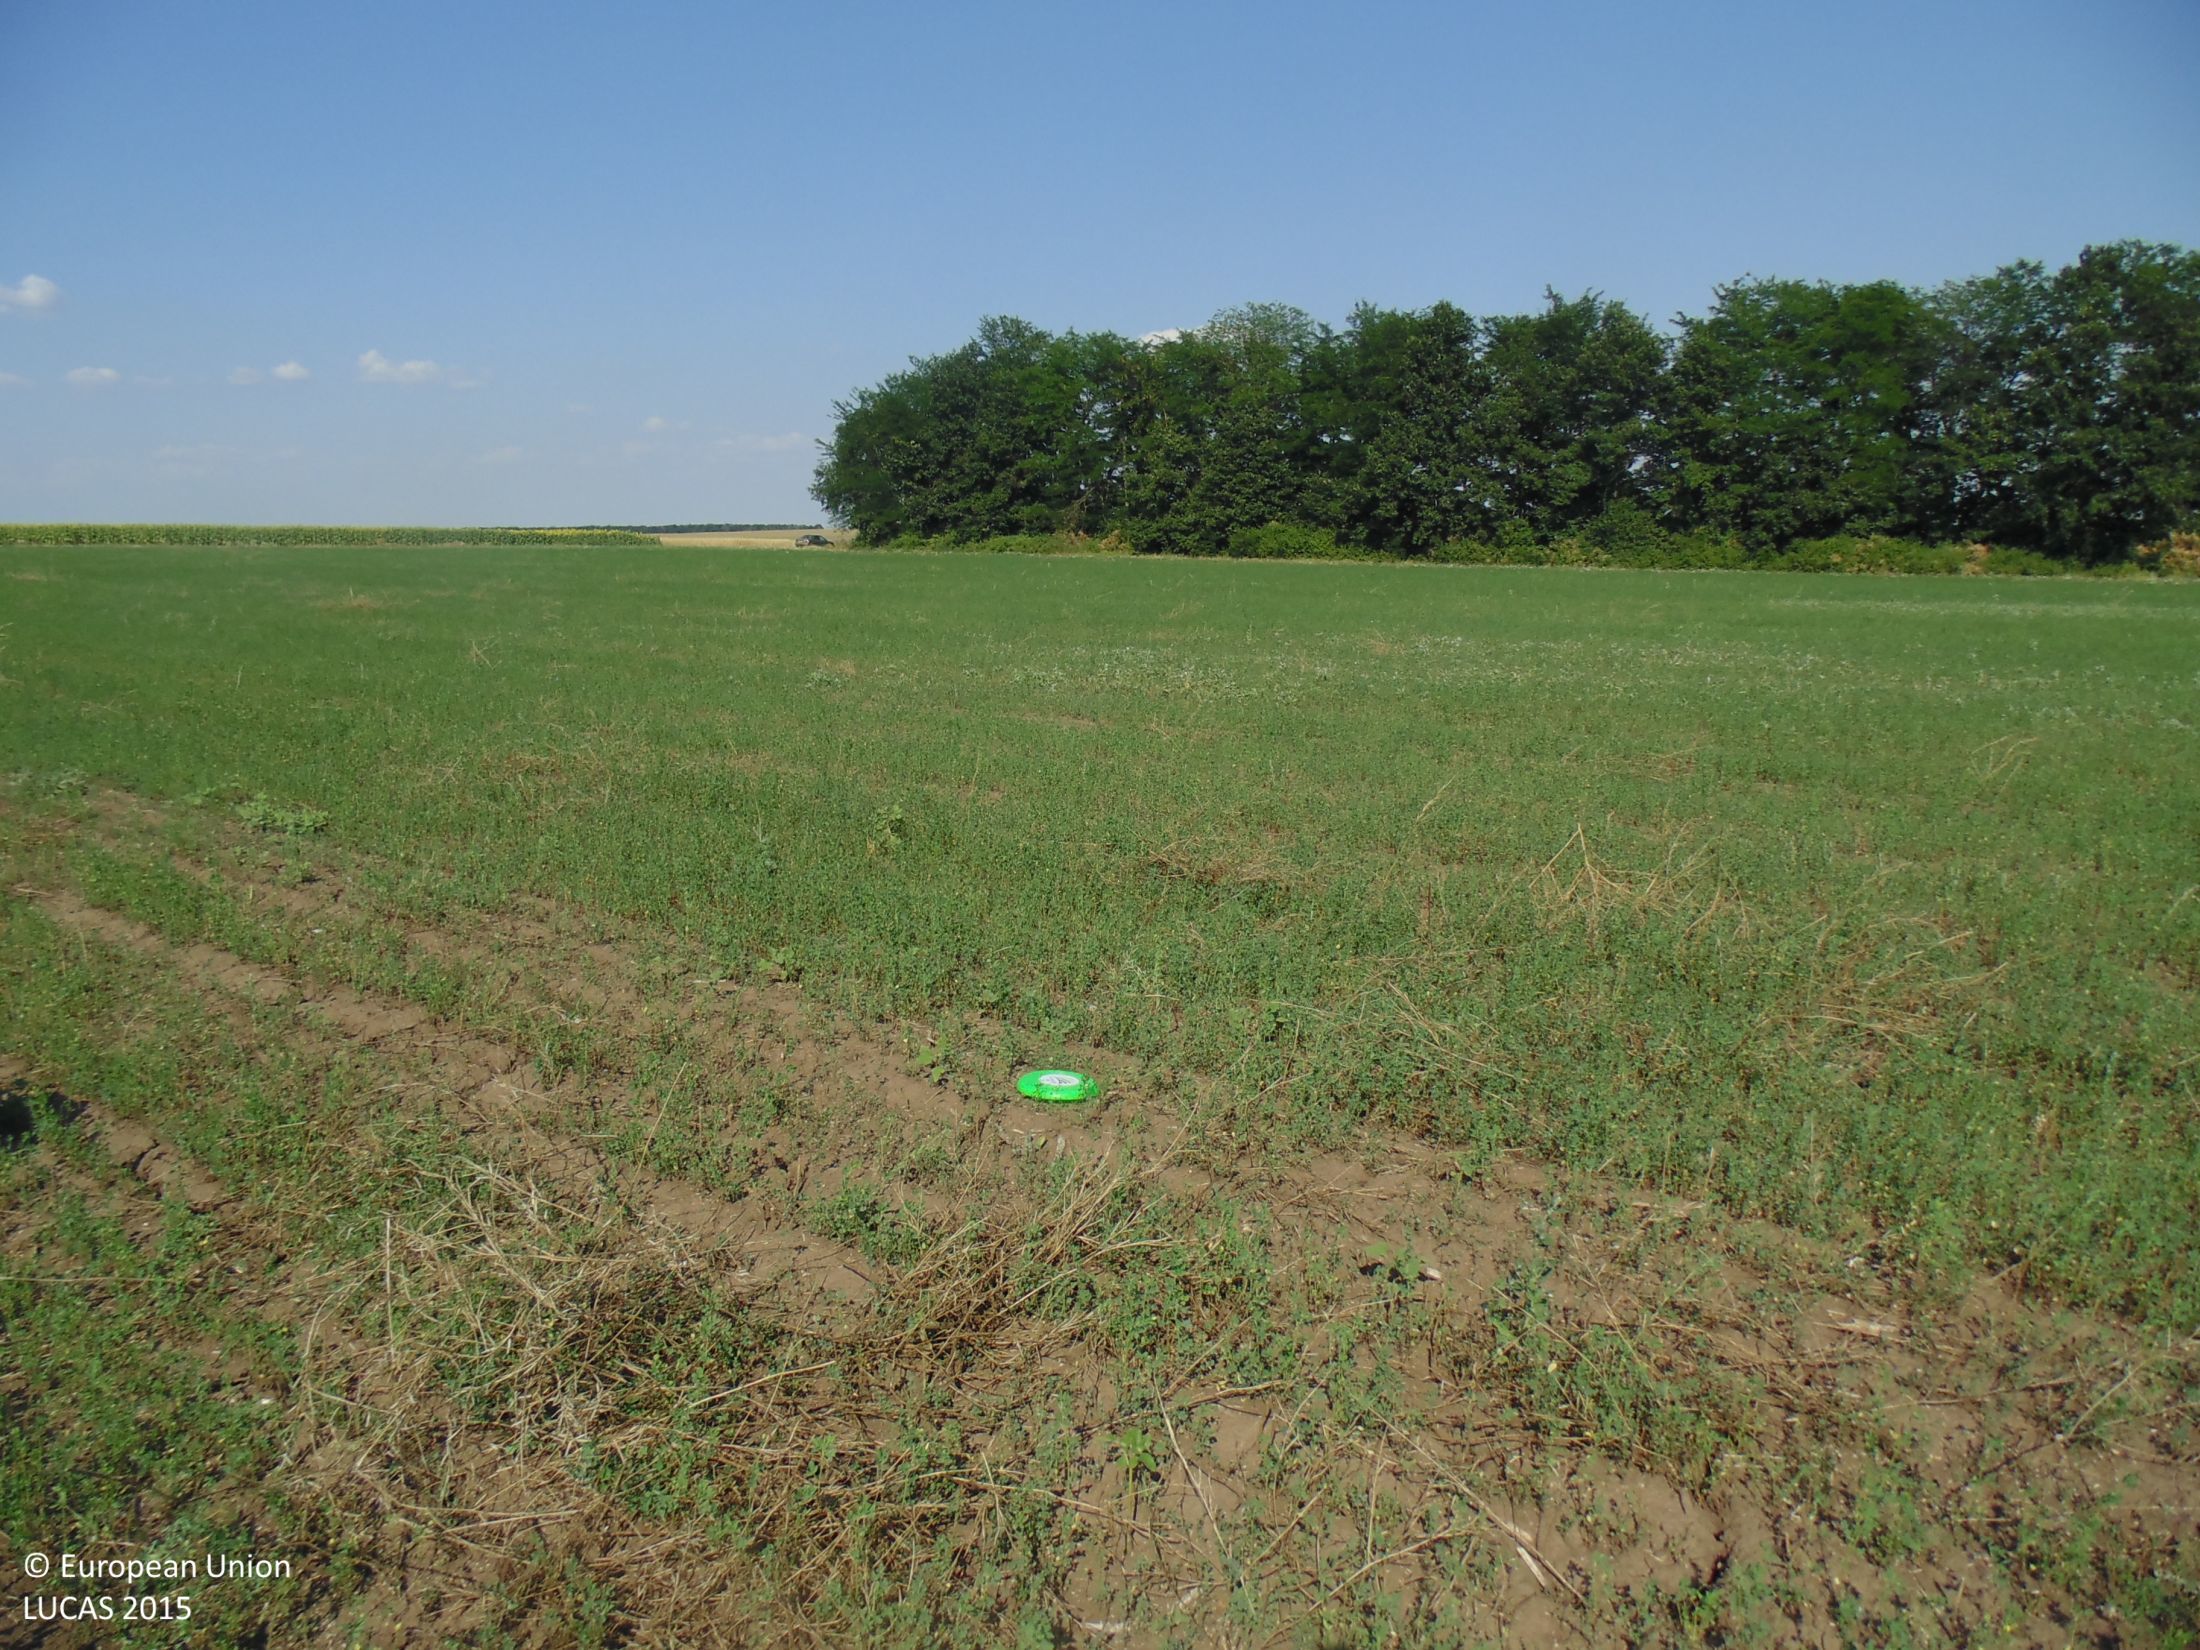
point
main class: Cropland
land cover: Lucerne
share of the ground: > 75 %
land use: Agriculture (excluding fallow land and kitchen gardens)
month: July
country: BG
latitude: 43.6197
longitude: 27.5190
